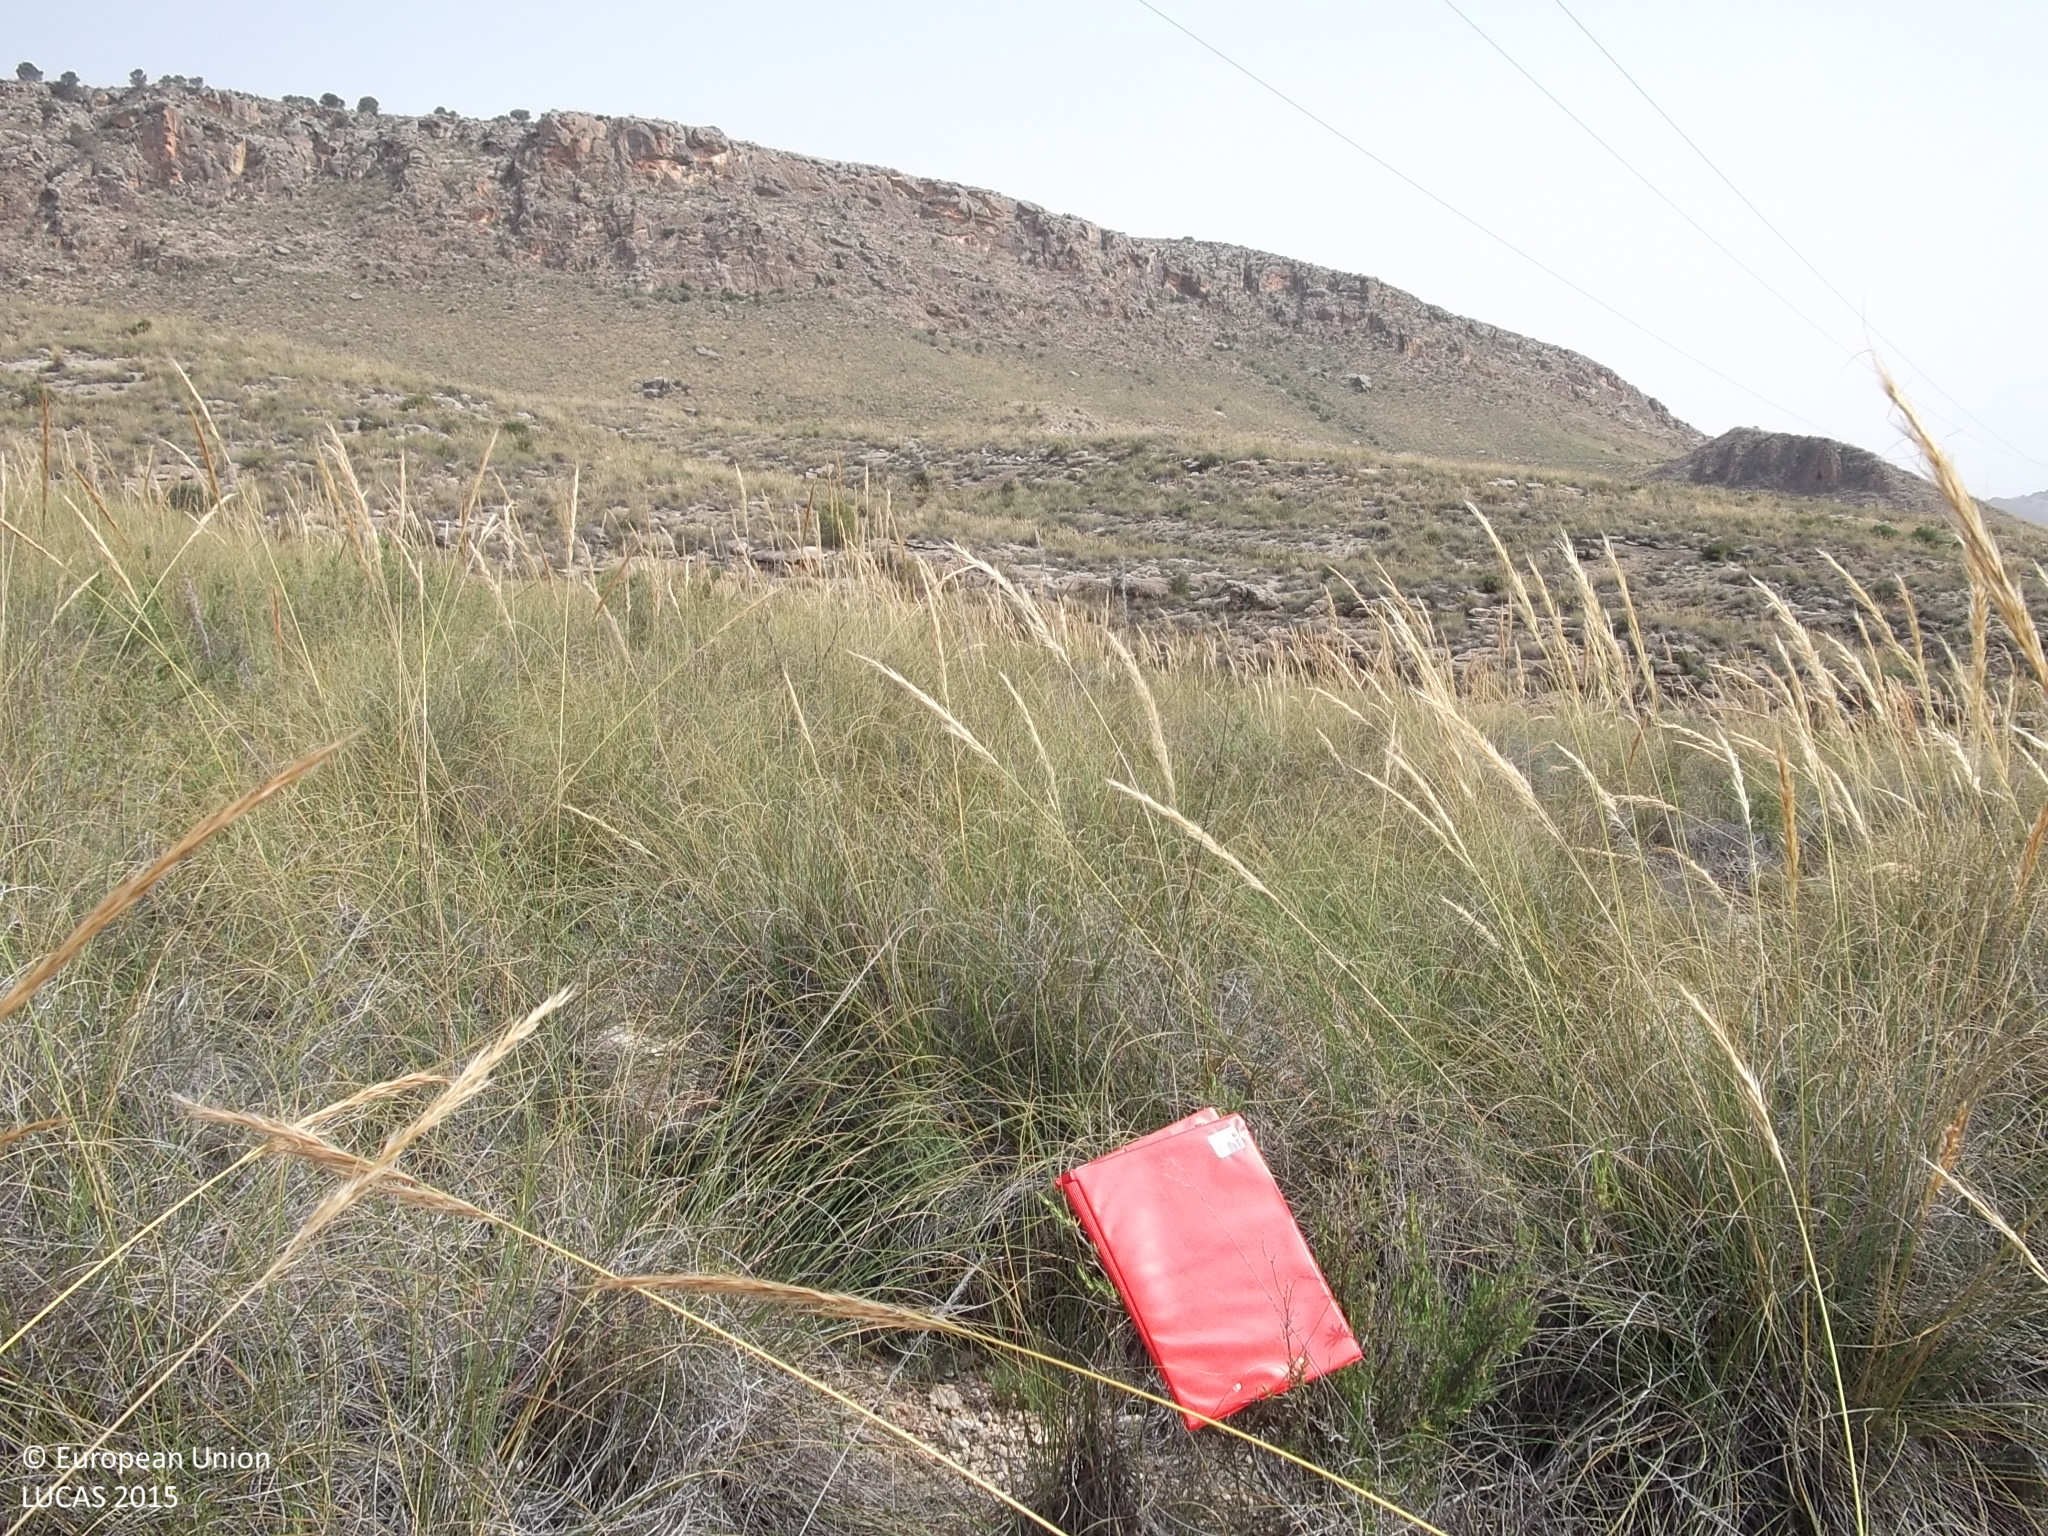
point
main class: Shrubland
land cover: Shrubland without tree cover
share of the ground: 25 - 50 %
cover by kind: consolidated bare surface 50 %, shrubs 25 %, herbaceous plants 25 %
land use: Semi-natural and natural areas not in use
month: May
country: ES
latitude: 38.4413
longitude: -1.6209
